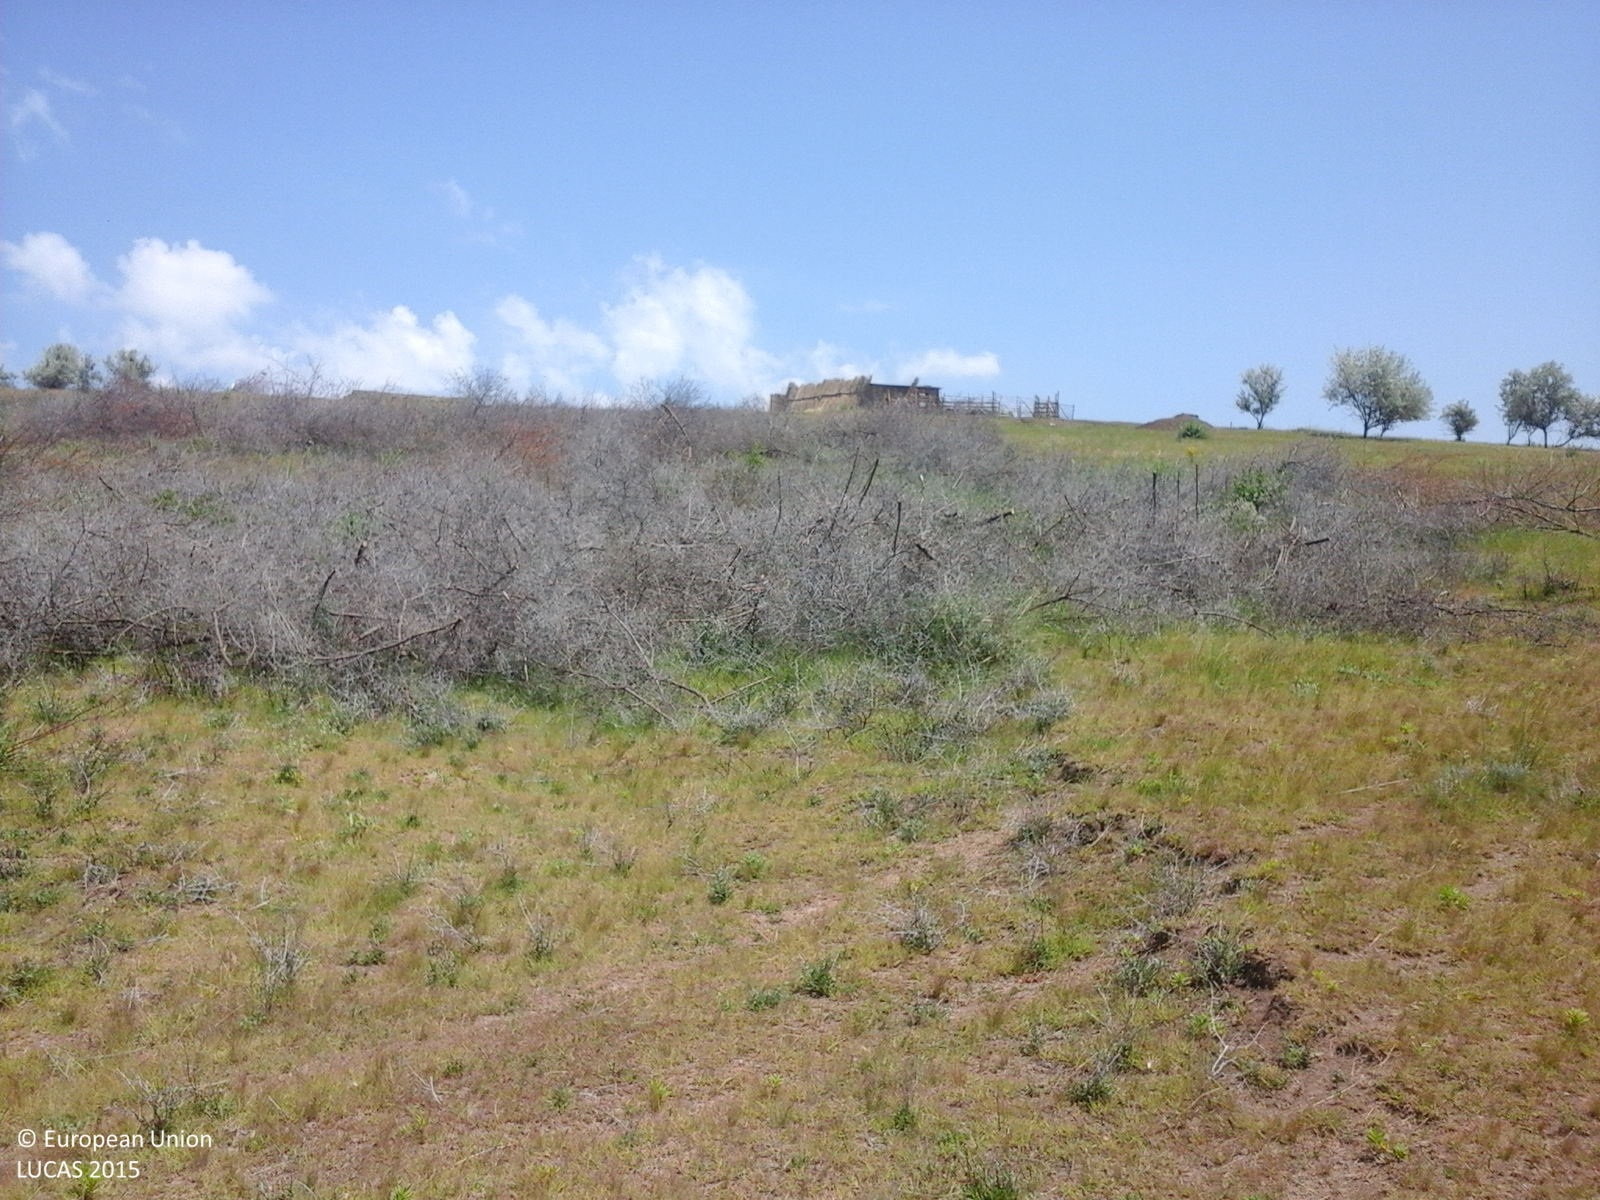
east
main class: Grassland
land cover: Grassland without tree/shrub cover
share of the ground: > 75 %
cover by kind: herbaceous plants 100 %
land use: Agriculture (excluding fallow land and kitchen gardens)
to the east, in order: Tracks; Grassland without tree/shrub cover; Shrubland with sparse tree cover; Grassland without tree/shrub cover; Artificial constructions in urban areas; Grassland without tree/shrub cover; Tracks; Grassland without tree/shrub cover
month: June
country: RO
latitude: 46.6662
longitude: 27.9134
